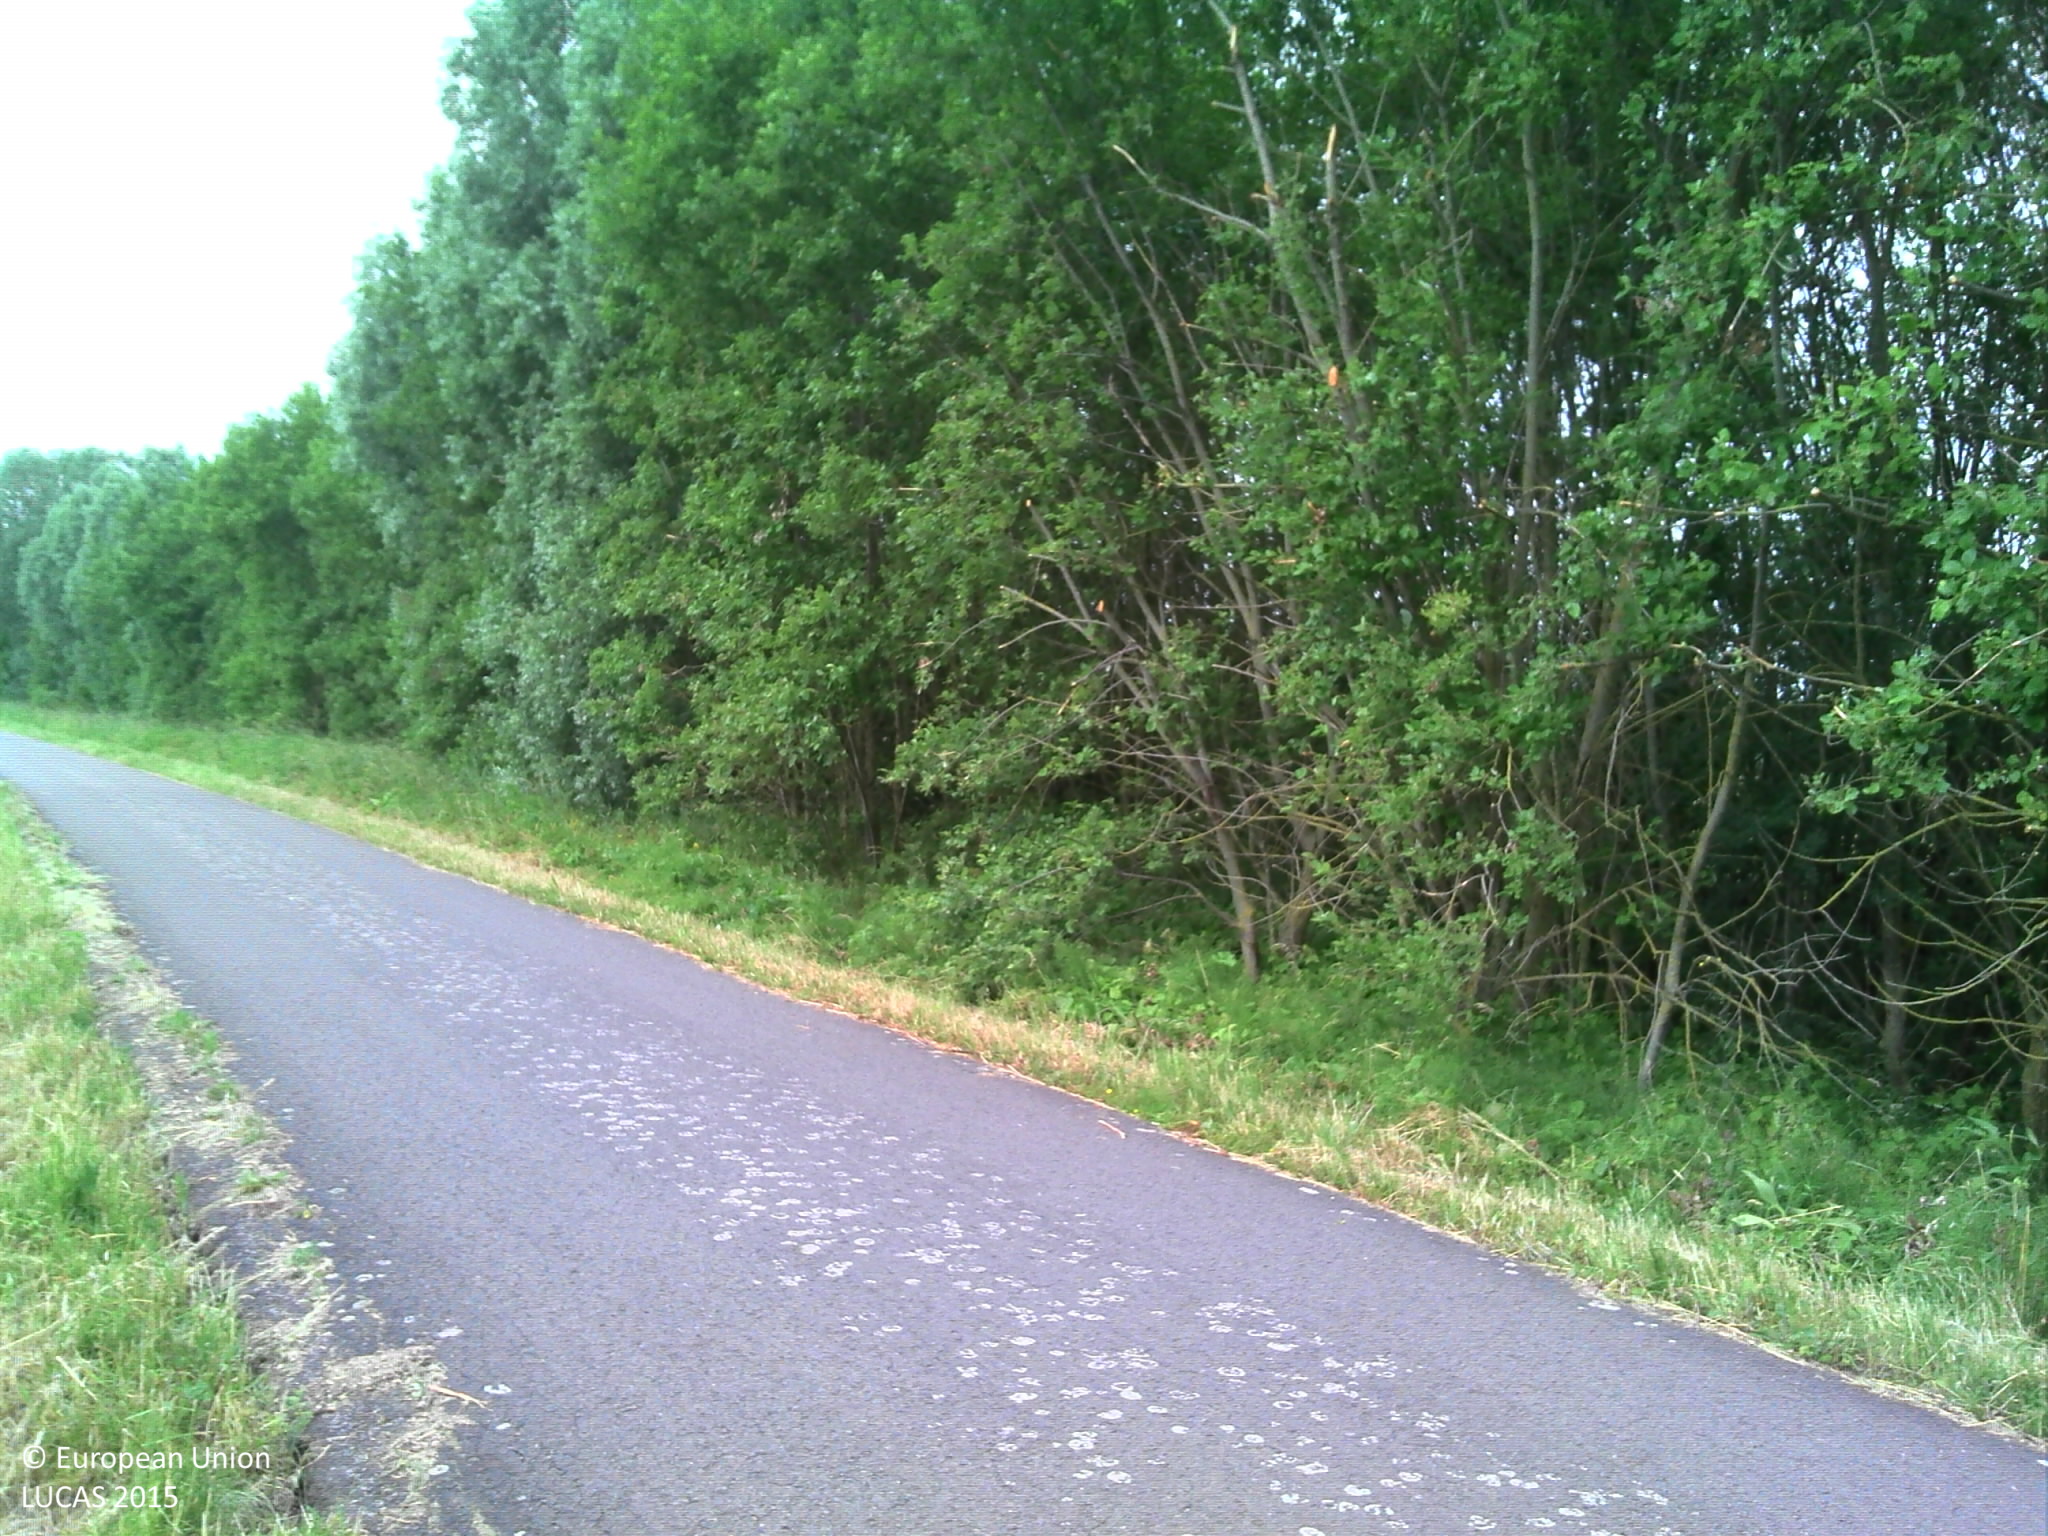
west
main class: Grassland
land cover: Spontaneously vegetated surfaces
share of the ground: > 75 %
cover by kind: herbaceous plants 100 %
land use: Semi-natural and natural areas not in use
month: June
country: BE
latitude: 50.8336
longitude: 3.5889
